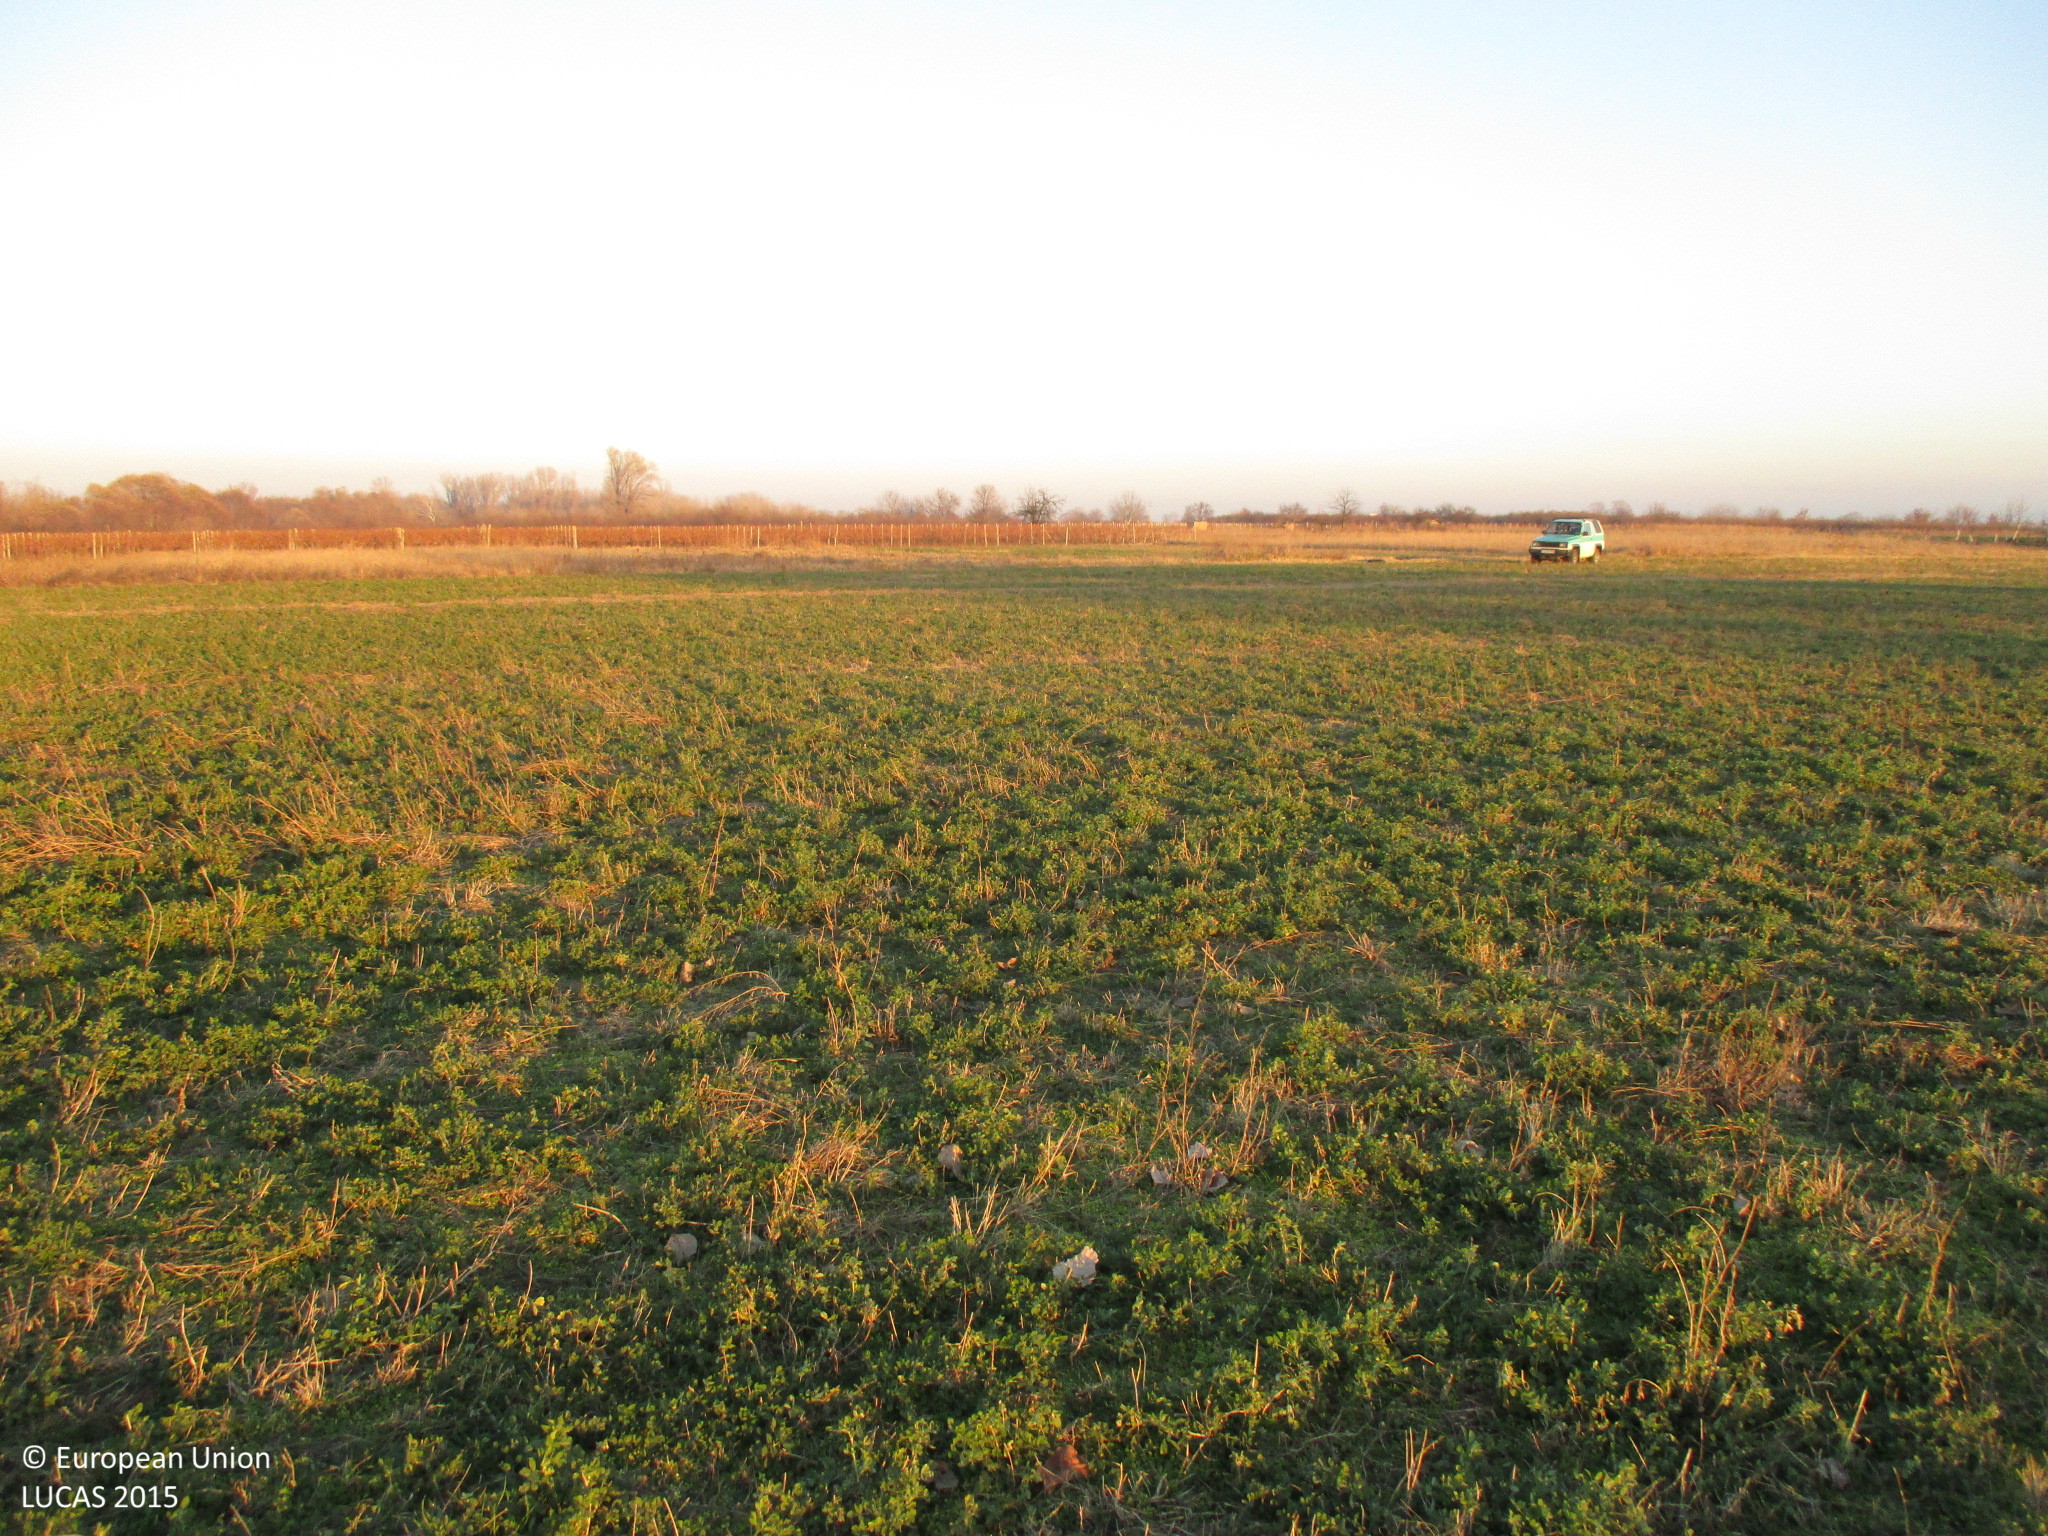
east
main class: Cropland
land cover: Lucerne
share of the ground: 50 - 75 %
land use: Agriculture (excluding fallow land and kitchen gardens)
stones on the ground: < 10 %
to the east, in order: Lucerne; Grass margins; Tracks; Lucerne; Grass margins; Vineyards; Grass margins; Tracks; Grass margins; Rape and turnip rape; Tracks; Other cereals
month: December
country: BG
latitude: 42.1245
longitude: 24.5759
